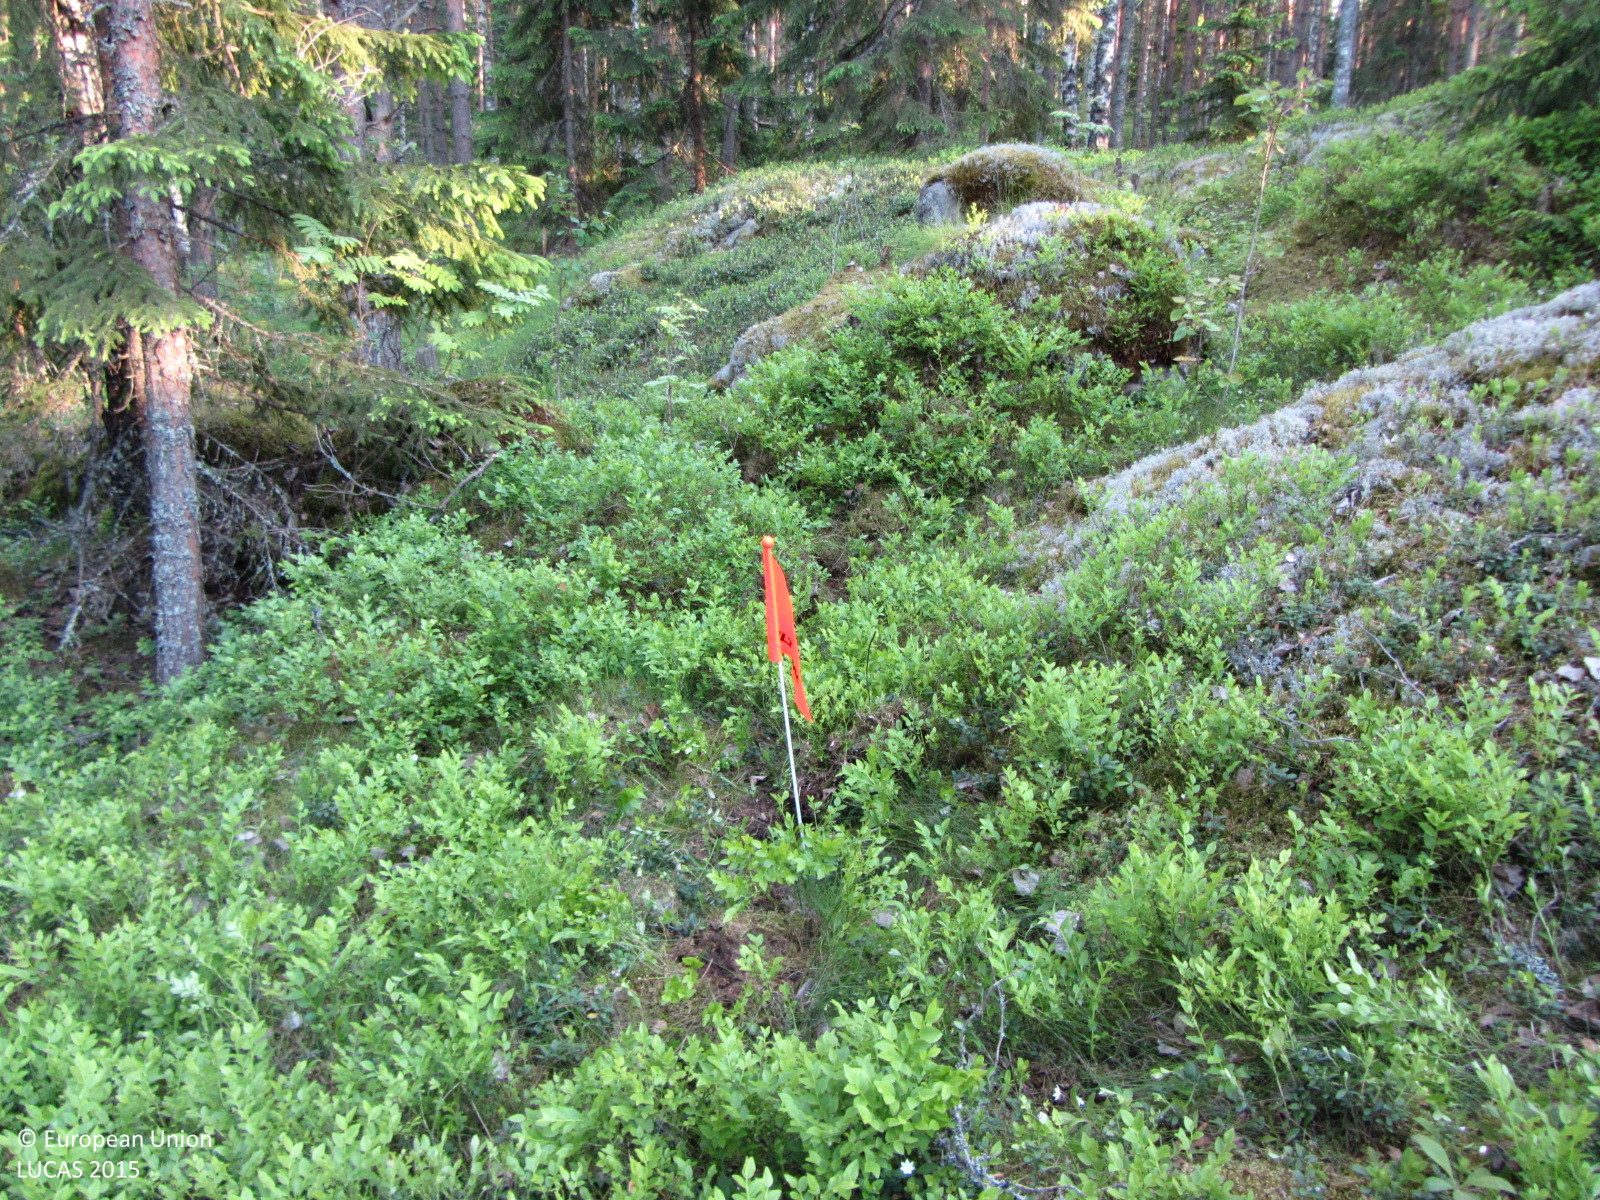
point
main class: Woodland
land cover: Other coniferous woodland
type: boreal forest
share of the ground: 50 - 75 %
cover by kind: coniferous forest trees 50 %, shrubs 30 %, broadleaved forest trees 10 %, lichens and mosses 10 %
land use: Forestry
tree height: > 5 m
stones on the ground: 10 - 25 %
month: June
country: FI
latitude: 60.3500
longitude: 24.2555
